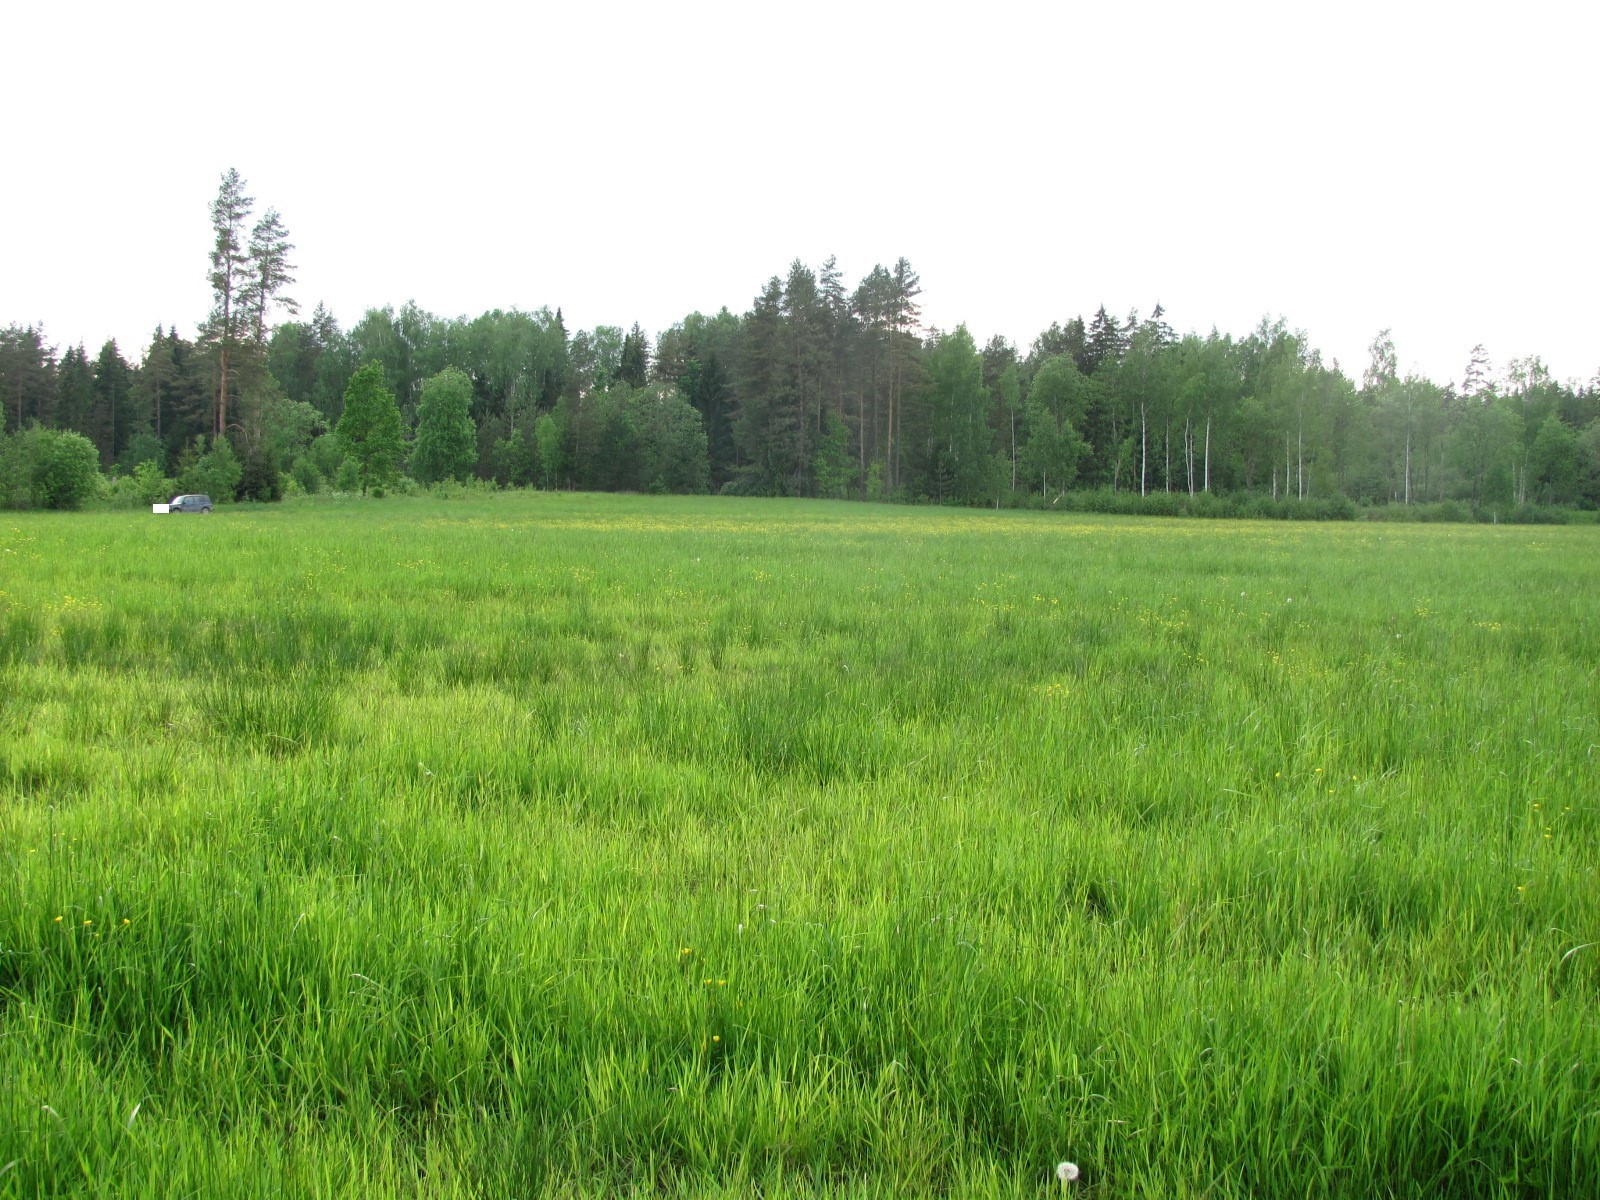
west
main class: Grassland
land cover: Grassland without tree/shrub cover
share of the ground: > 75 %
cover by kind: herbaceous plants 100 %
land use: Agriculture (excluding fallow land and kitchen gardens)
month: June
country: LV
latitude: 56.6793
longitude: 24.3078
